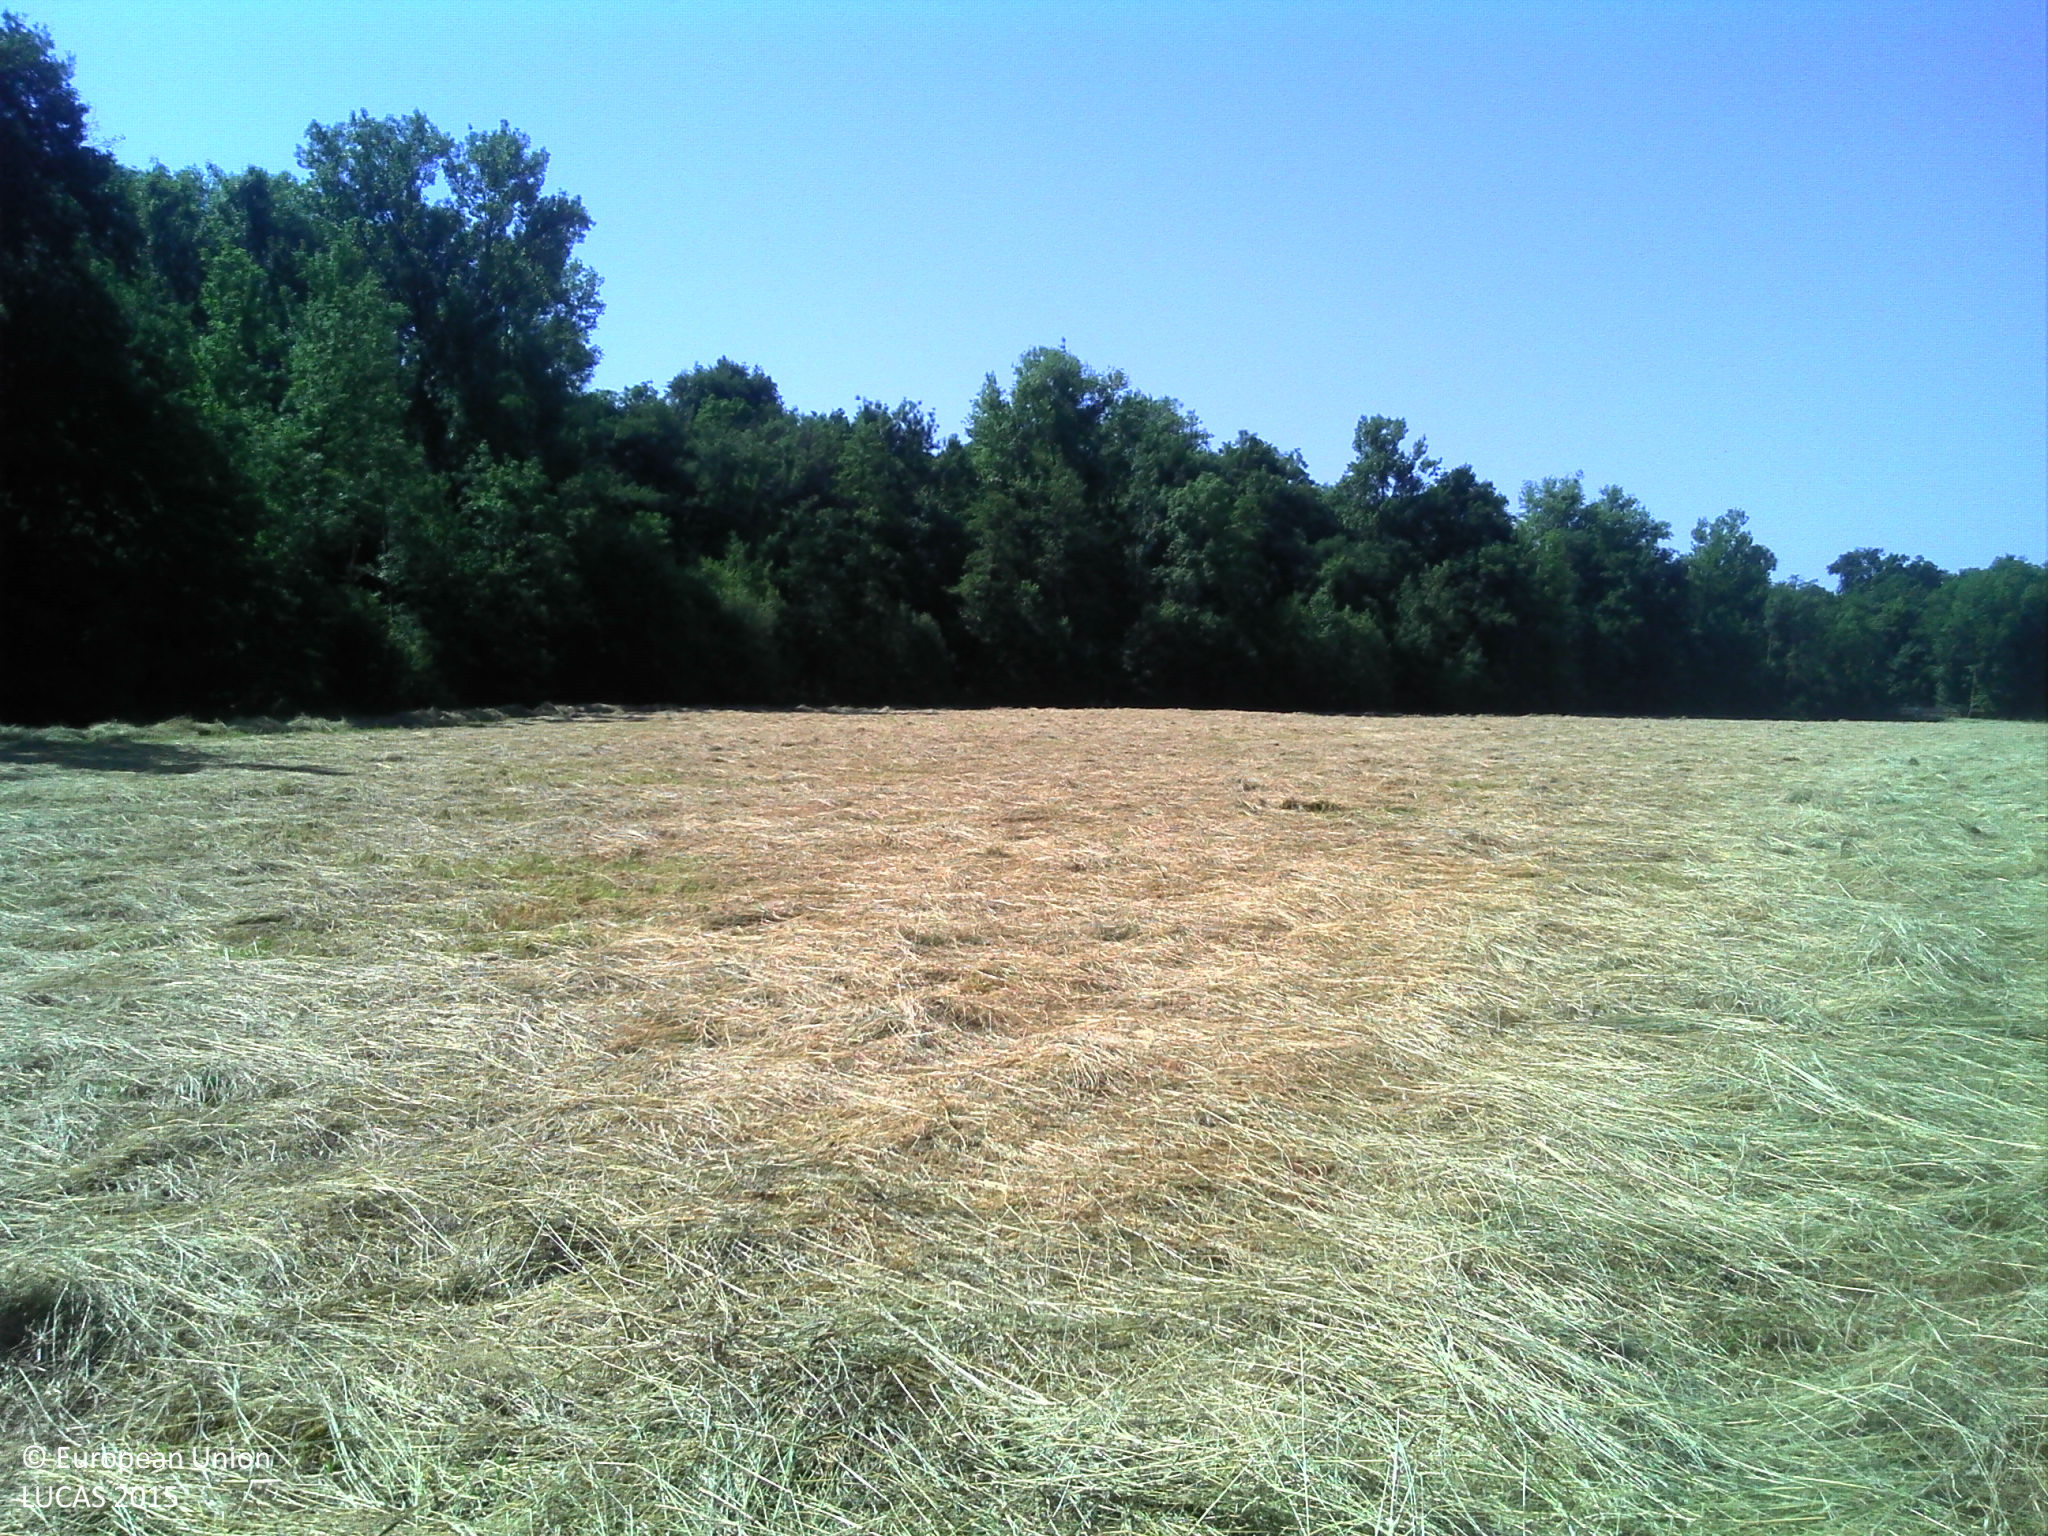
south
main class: Grassland
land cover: Grassland without tree/shrub cover
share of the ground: > 75 %
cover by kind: herbaceous plants 100 %
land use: Agriculture (excluding fallow land and kitchen gardens)
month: June
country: FR
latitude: 48.3968
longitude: 7.6643
